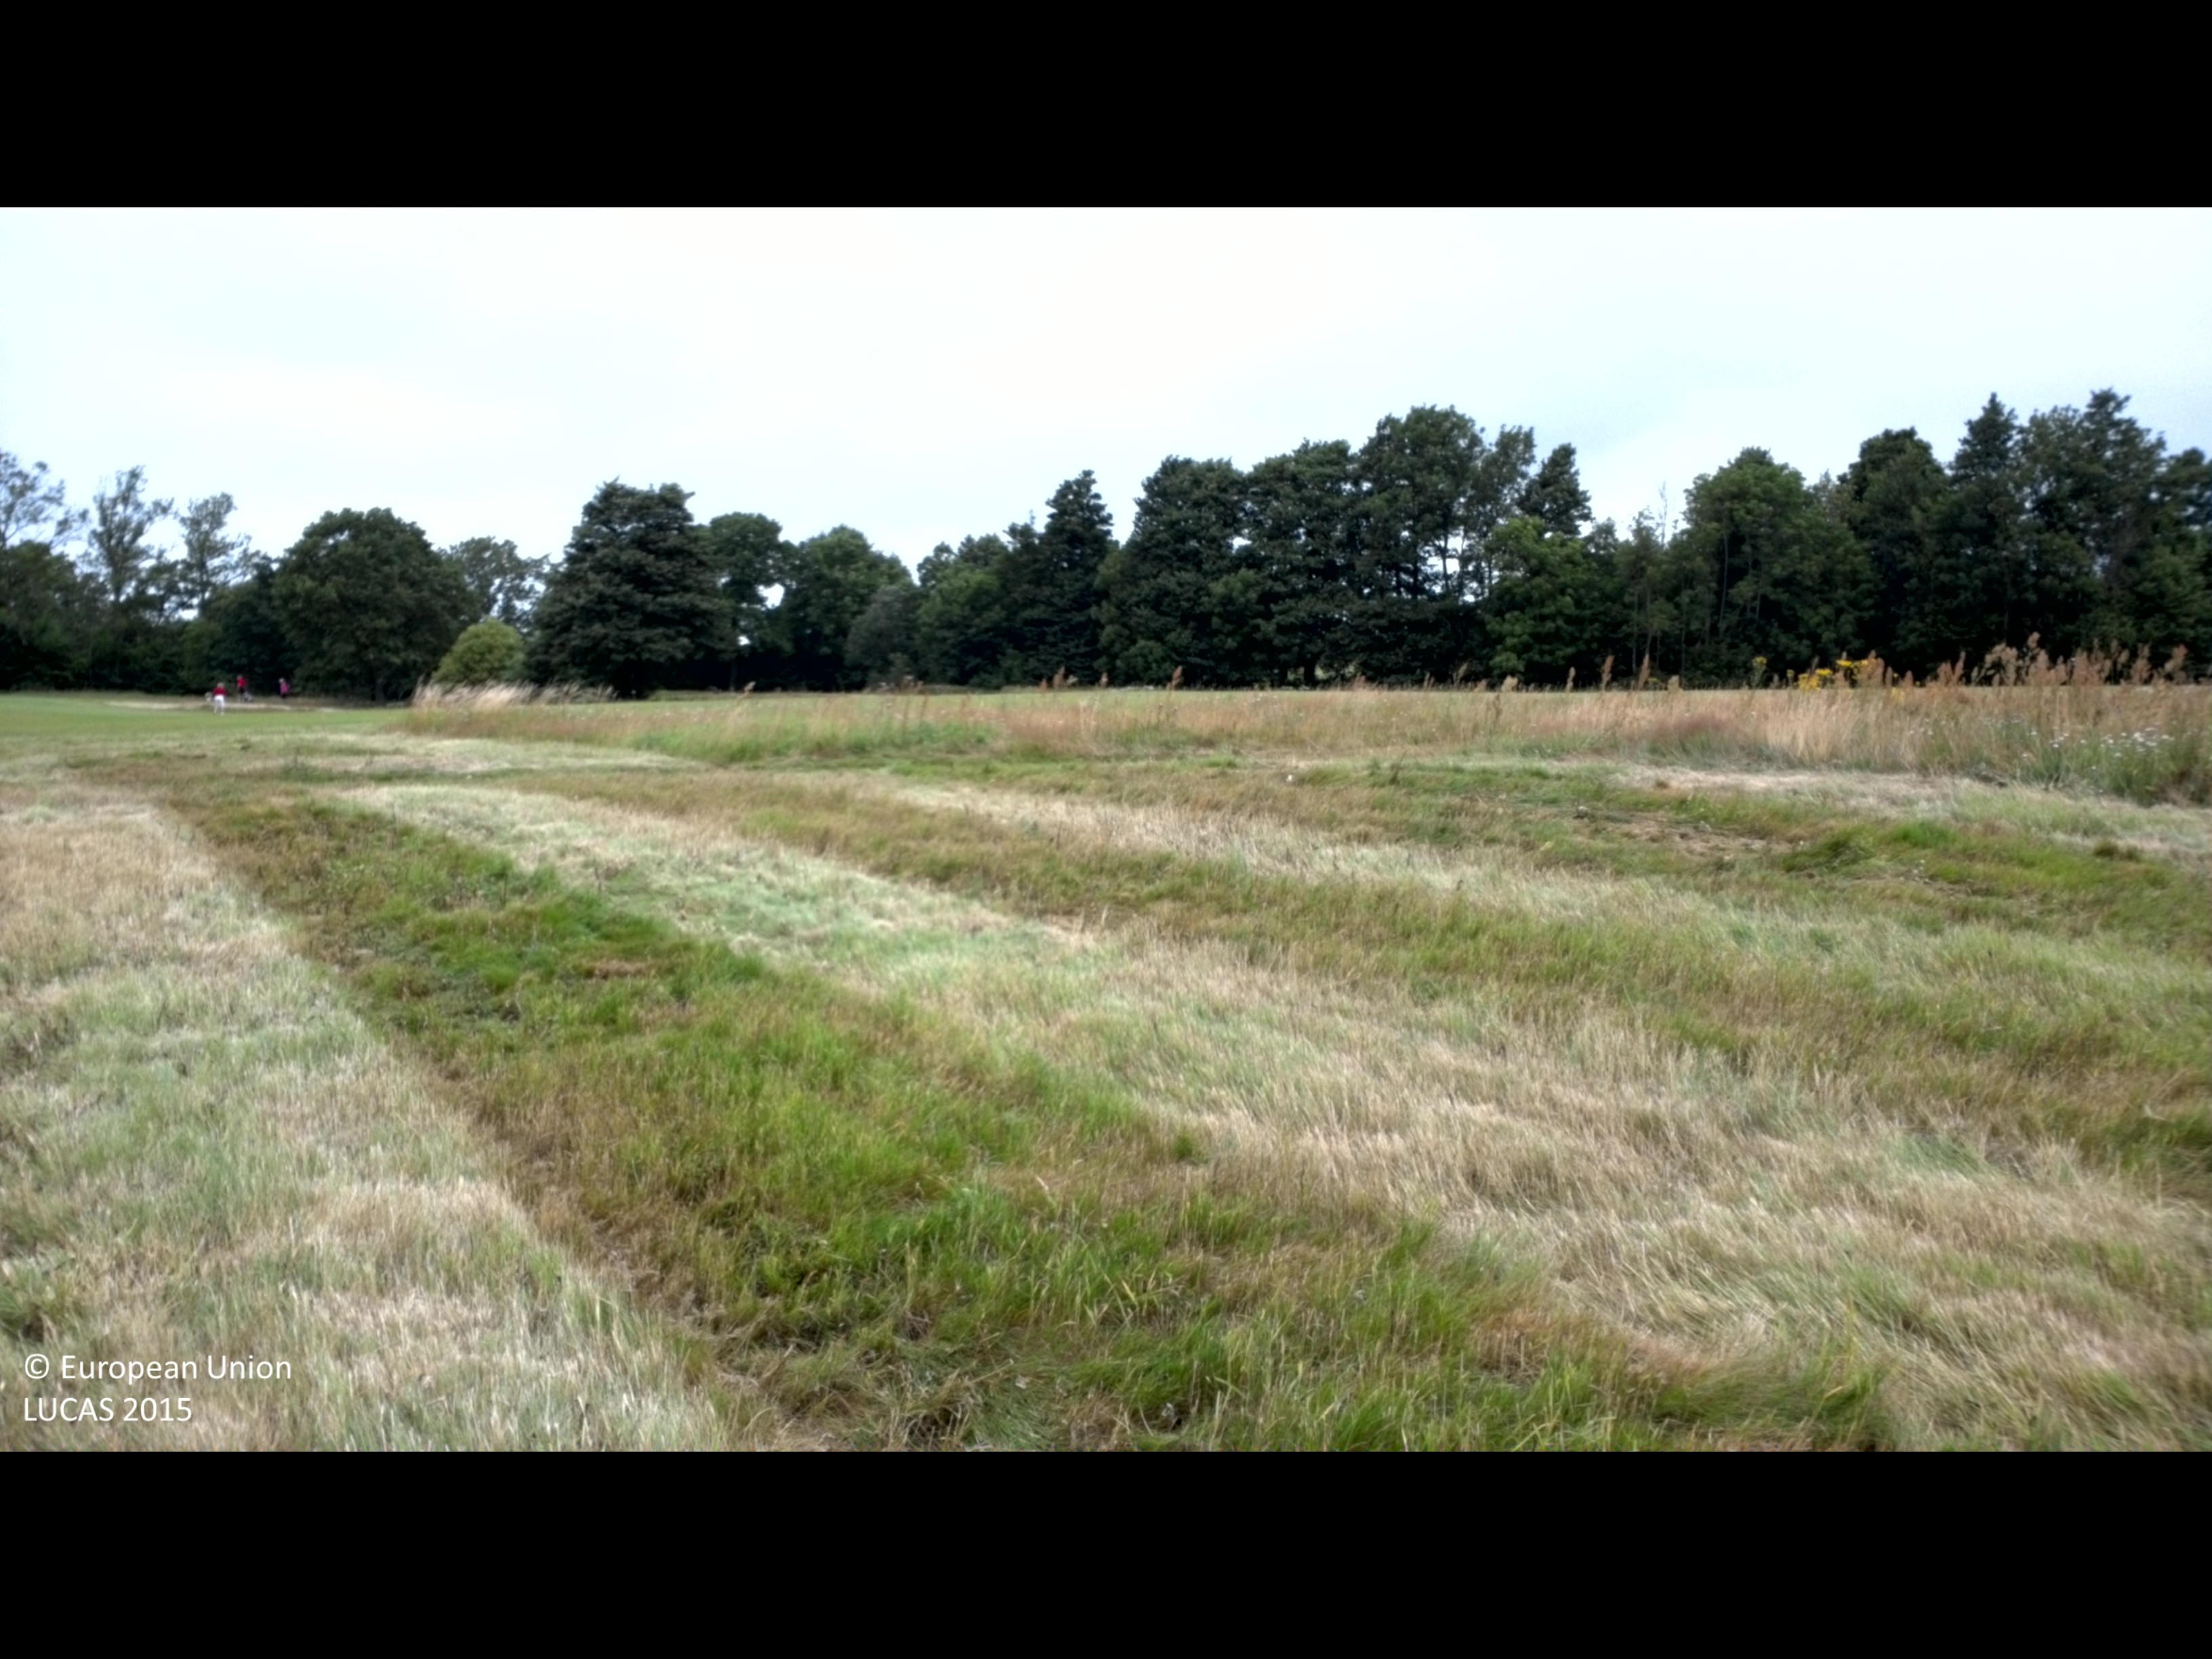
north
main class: Grassland
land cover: Grassland without tree/shrub cover
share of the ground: > 75 %
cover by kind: herbaceous plants 100 %
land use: Sport
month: July
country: SE
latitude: 56.7776
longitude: 16.5637
